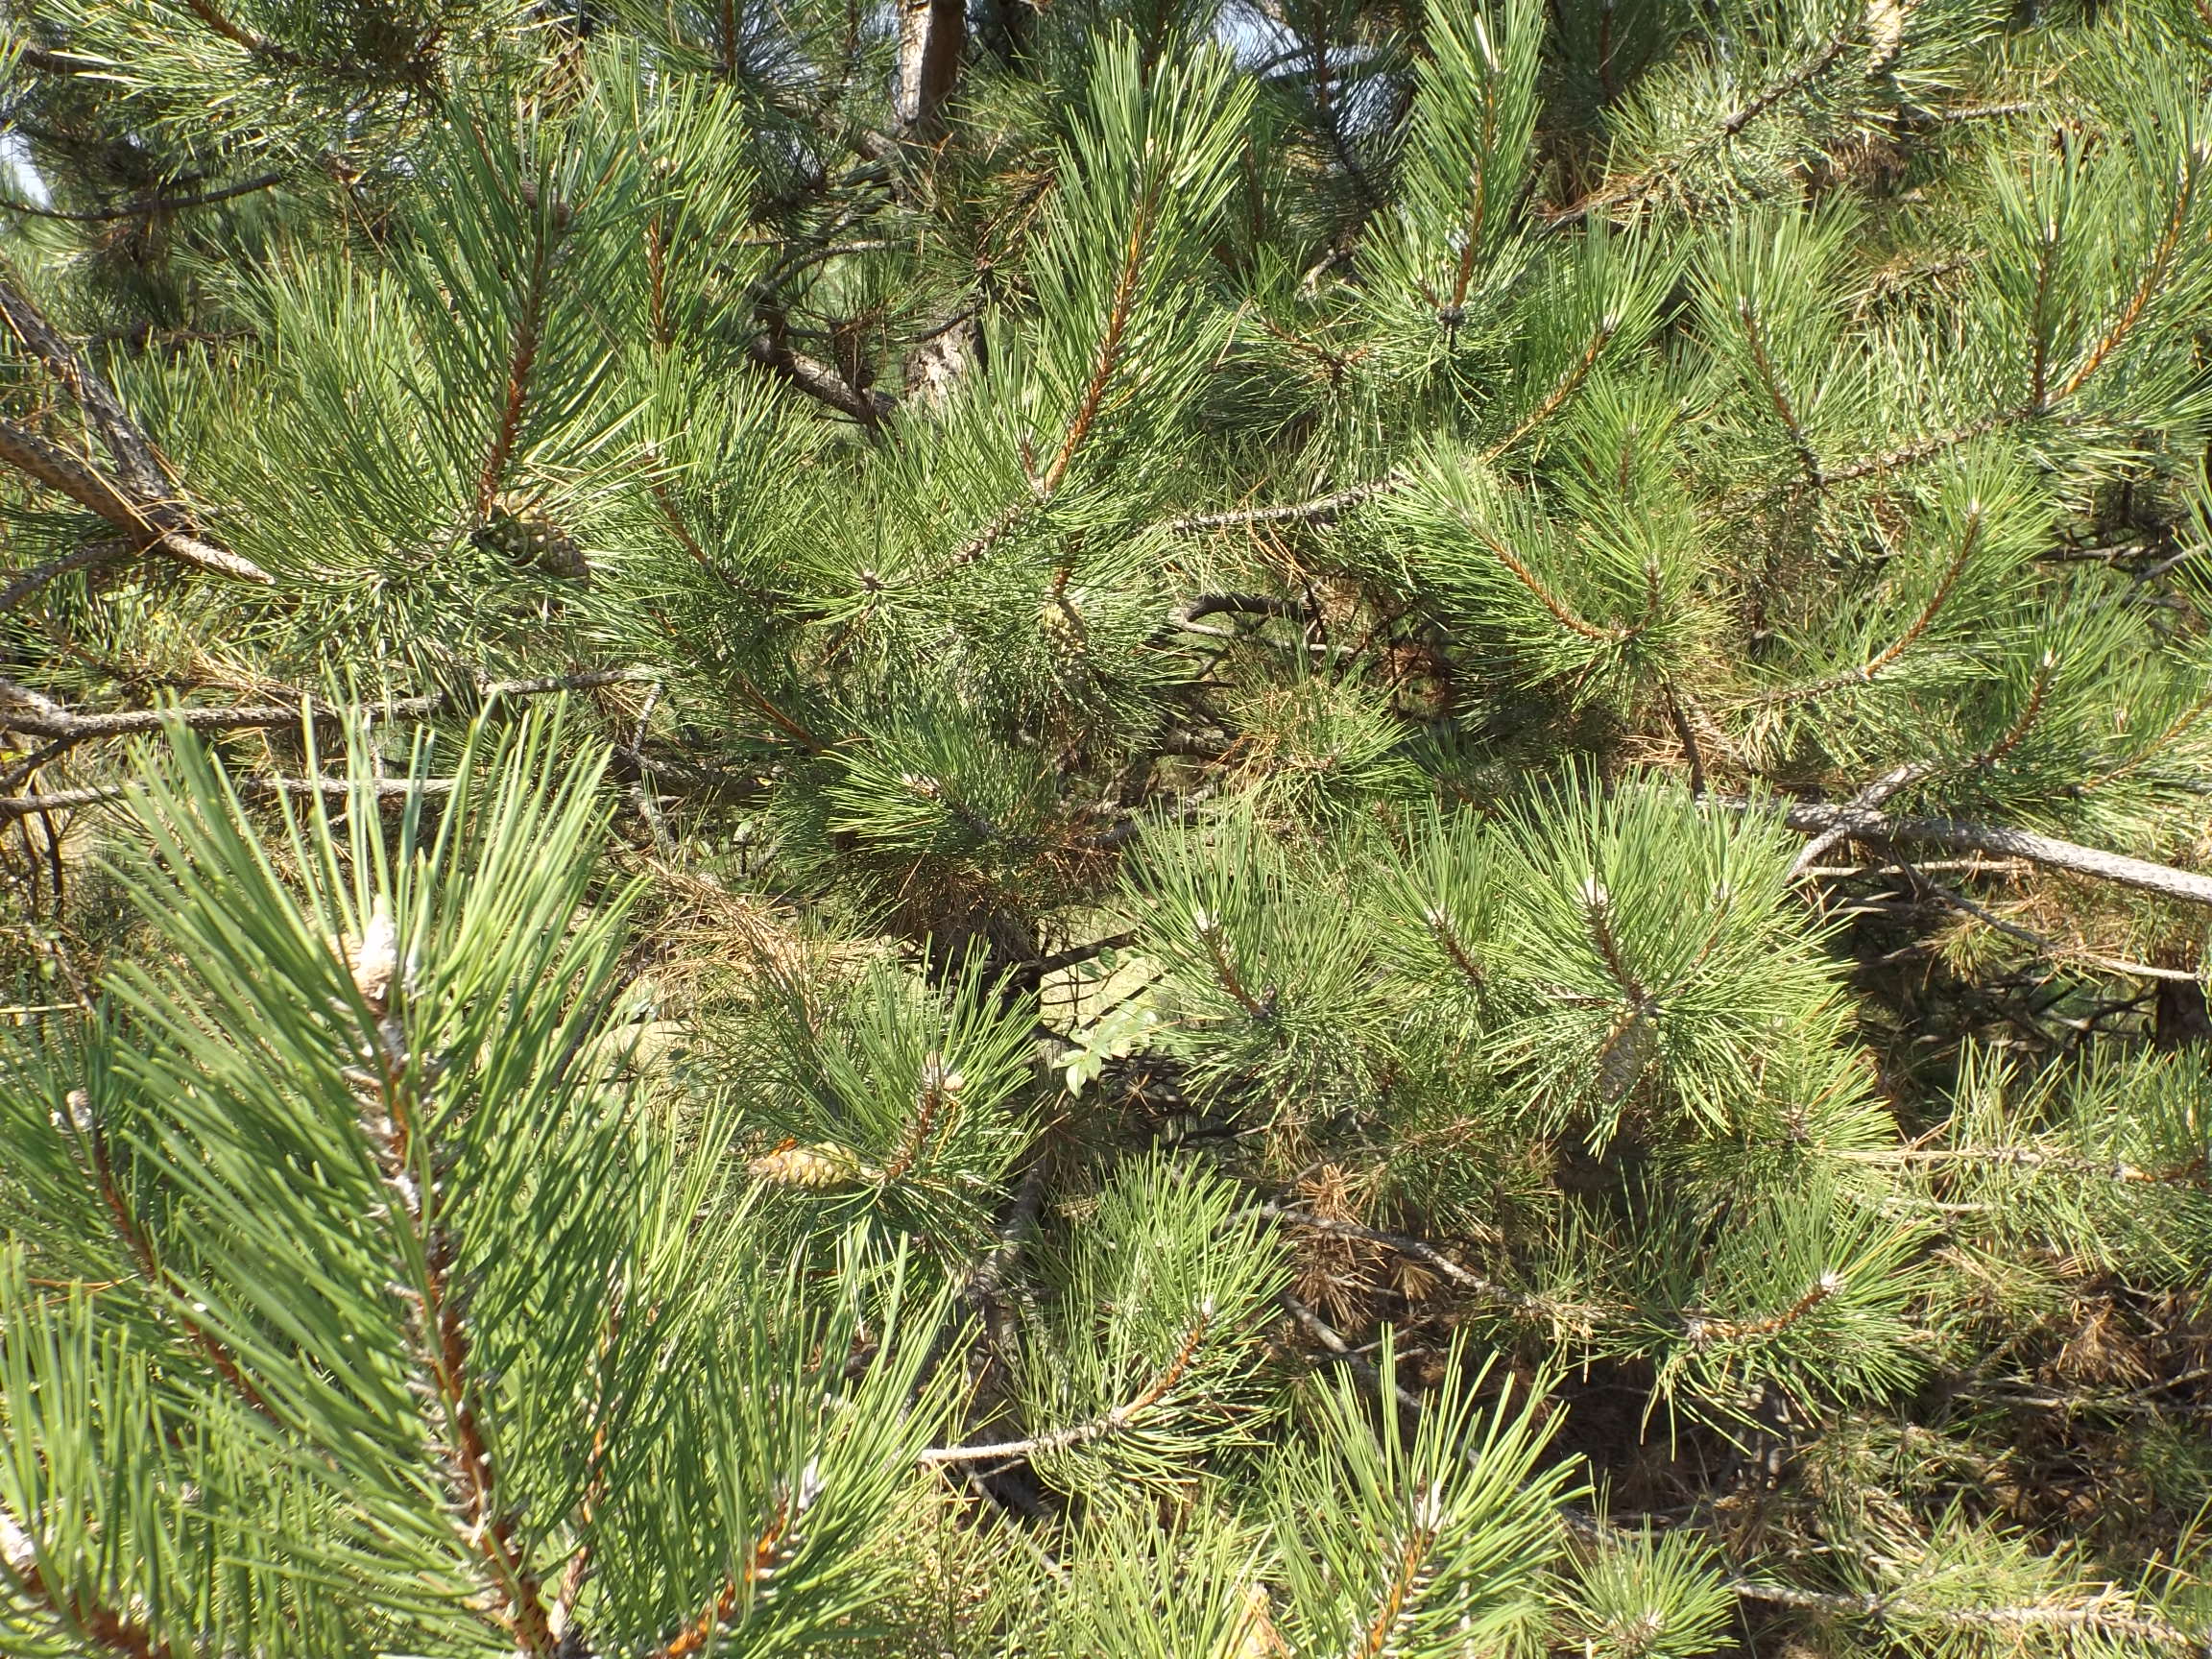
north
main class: Woodland
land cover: Pine dominated coniferous woodland
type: alpine coniferous forest
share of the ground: 50 - 75 %
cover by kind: coniferous forest trees 55 %, herbaceous plants 40 %, shrubs 5 %
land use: Forestry
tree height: < 5 m
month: August
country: BG
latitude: 43.0906
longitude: 27.3827
